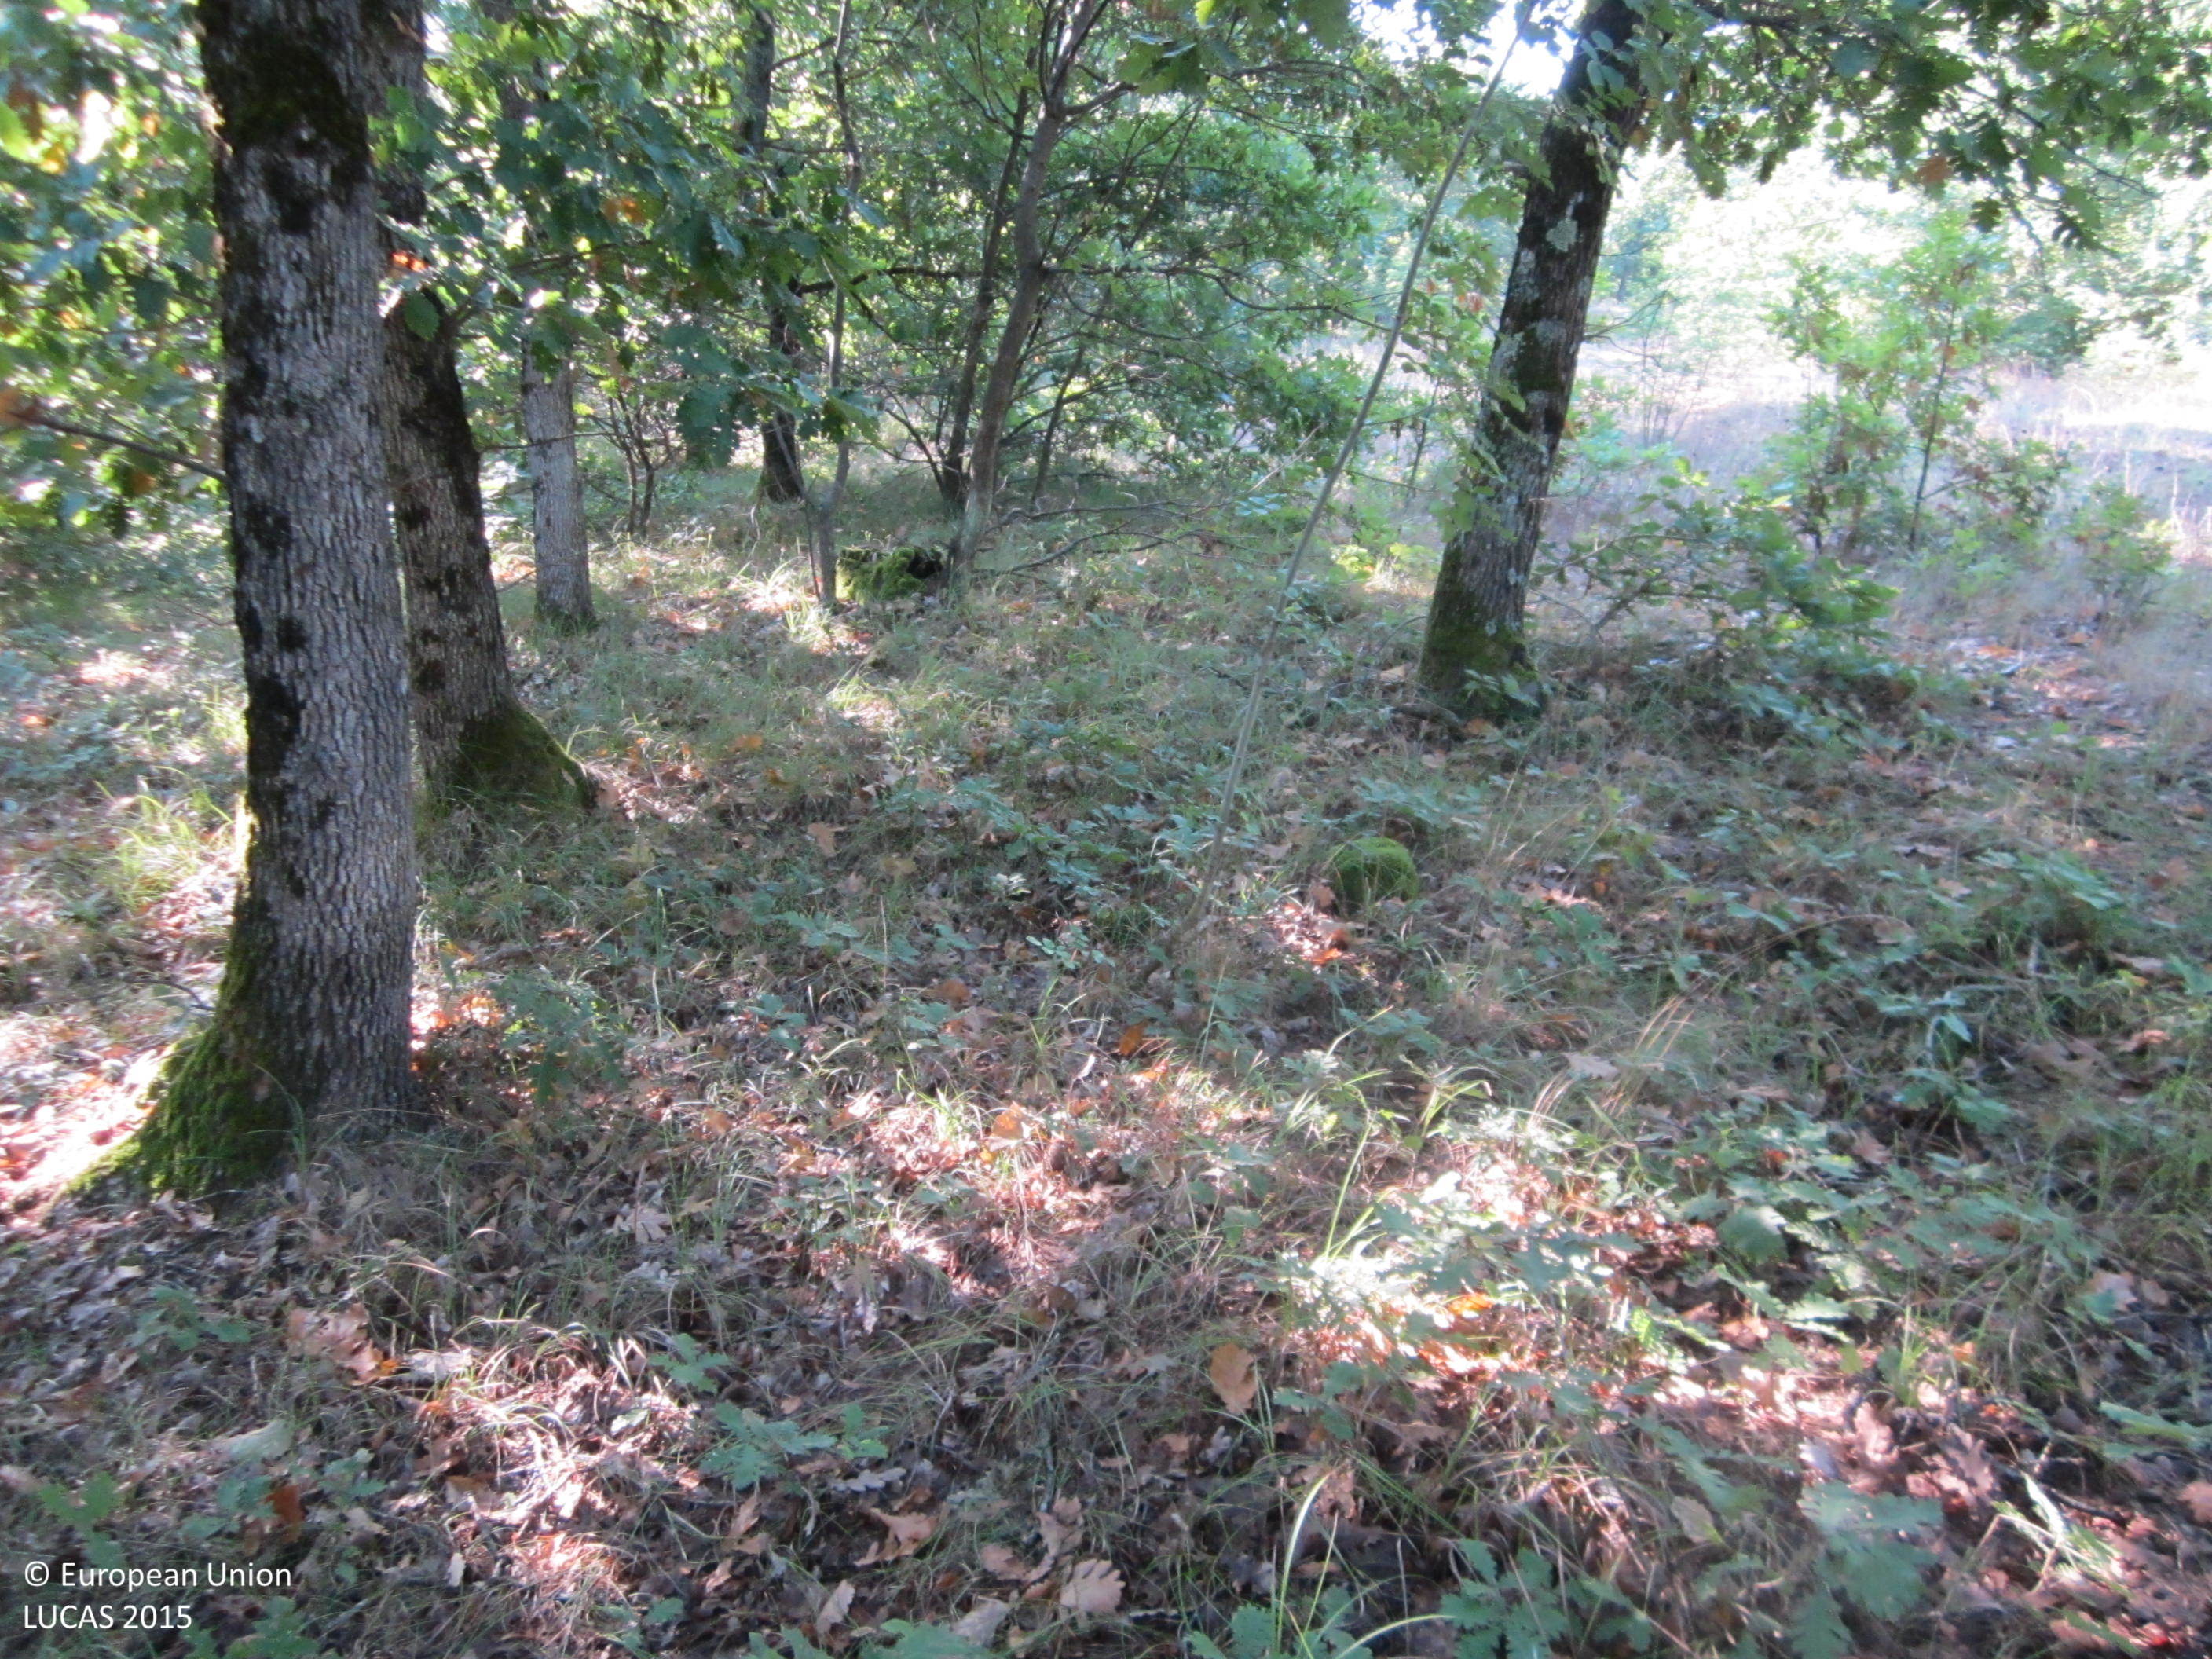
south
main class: Woodland
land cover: Broadleaved woodland
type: thermophilous deciduous forest
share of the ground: 50 - 75 %
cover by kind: broadleaved forest trees 65 %, herbaceous plants 30 %, lichens and mosses 5 %
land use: Forestry
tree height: > 5 m
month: September
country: BG
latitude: 42.3693
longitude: 27.2932
